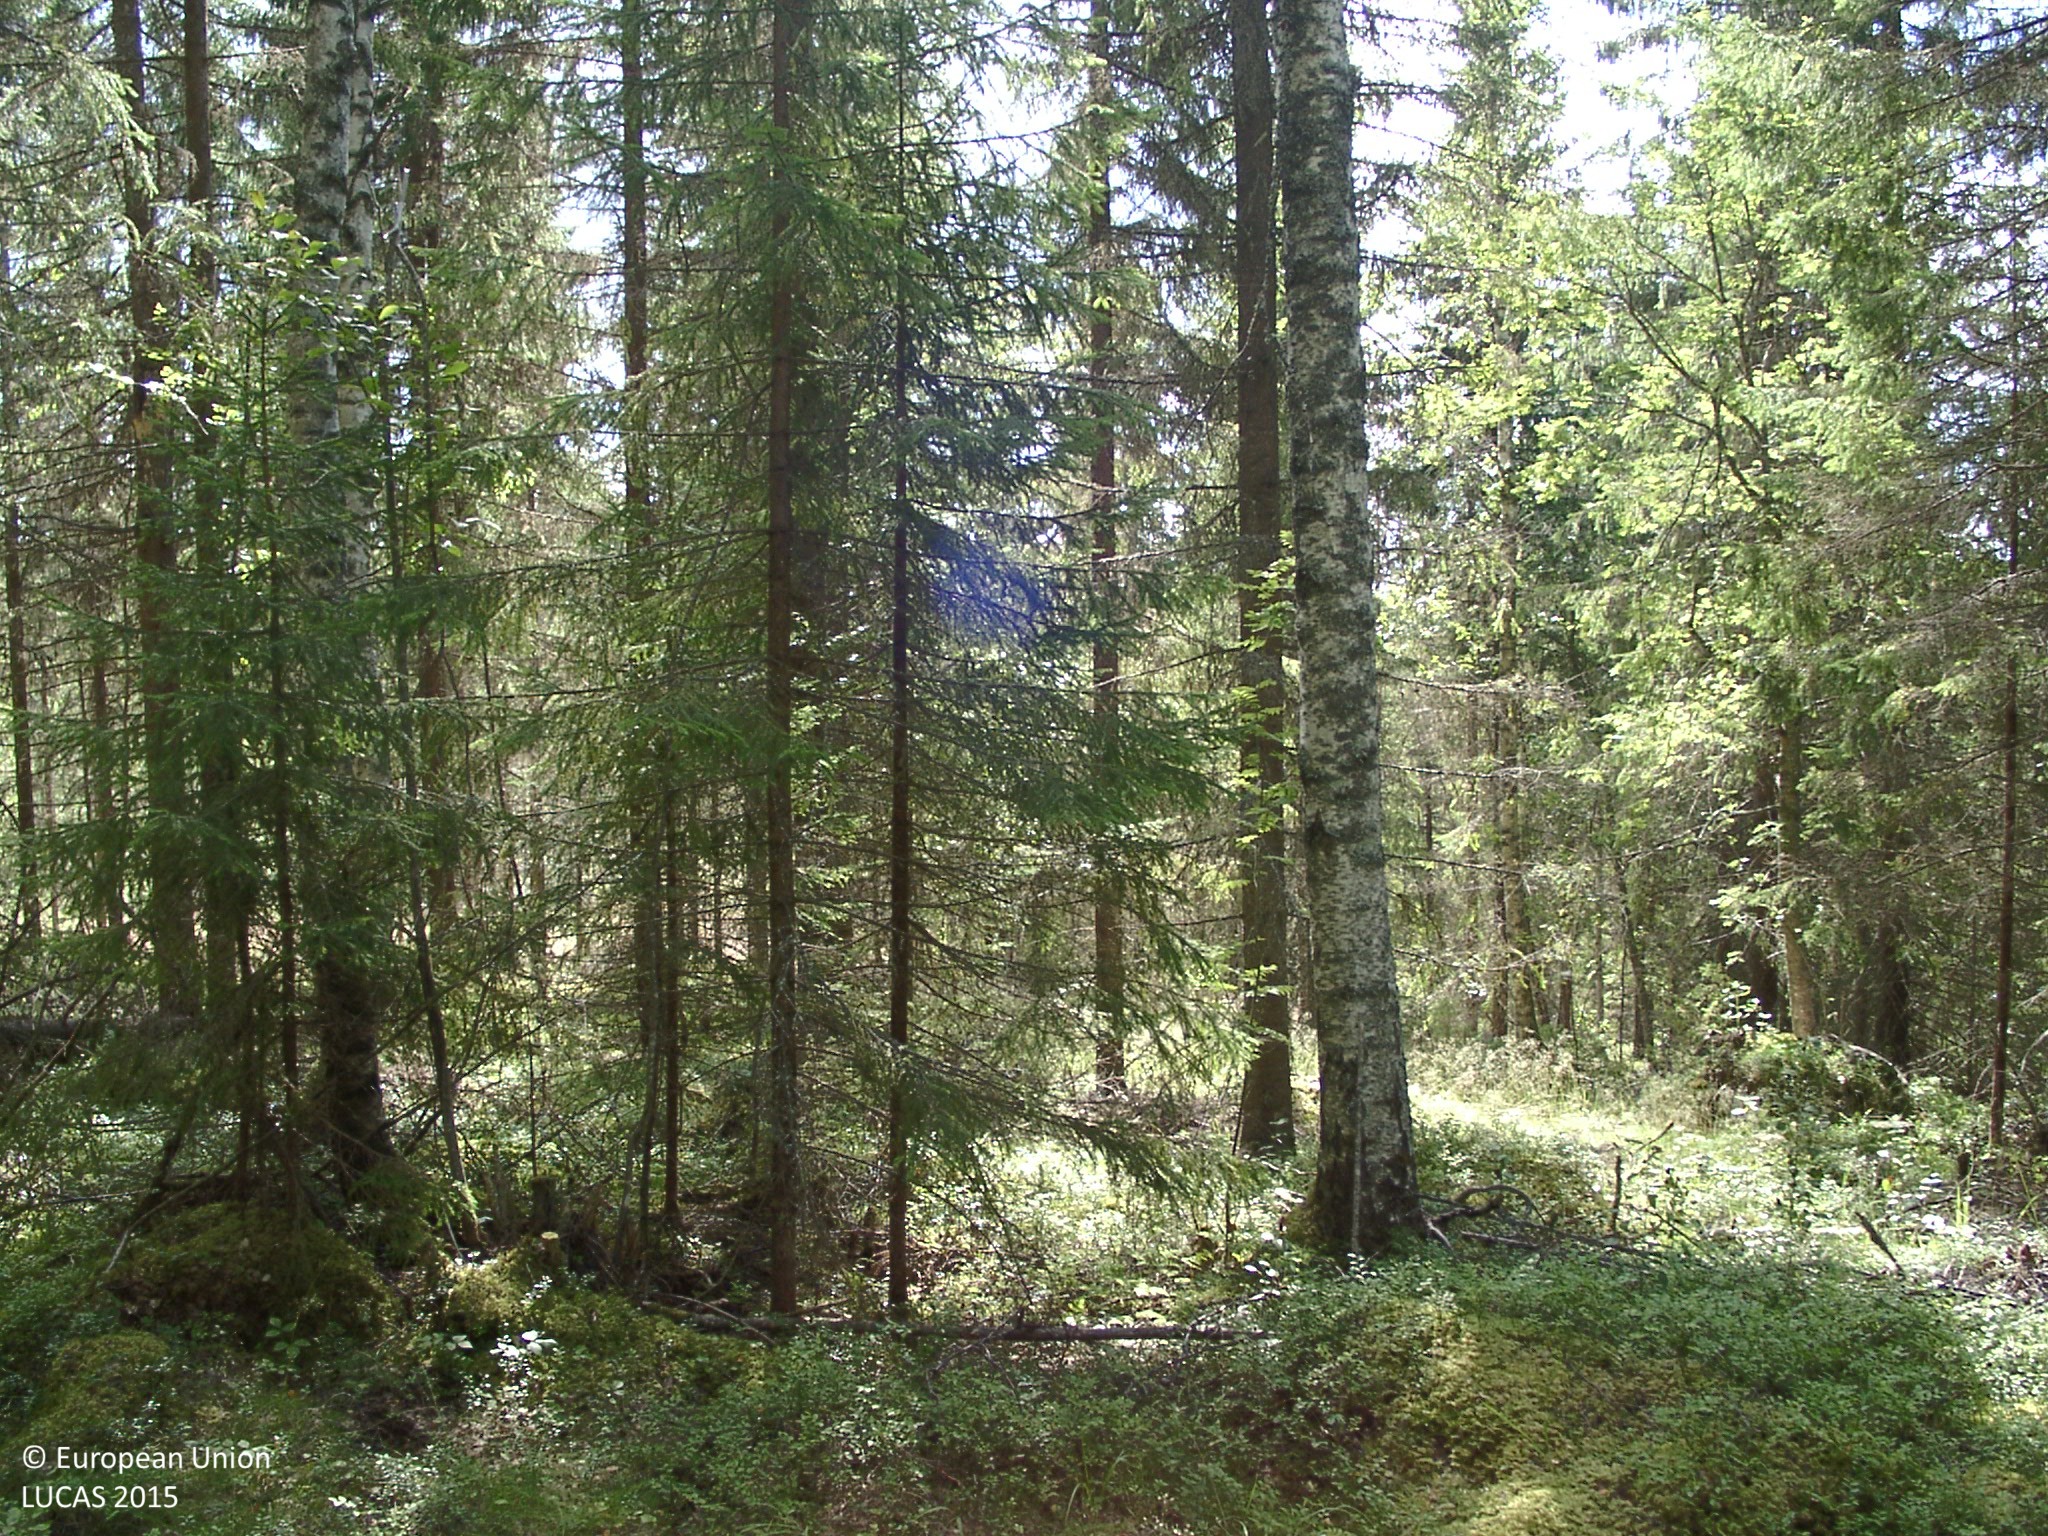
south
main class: Woodland
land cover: Spruce dominated mixed woodland
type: boreal forest
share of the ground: 50 - 75 %
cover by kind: coniferous forest trees 50 %, broadleaved forest trees 20 %, shrubs 15 %, lichens and mosses 10 %, herbaceous plants 5 %
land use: Forestry
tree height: > 5 m
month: August
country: FI
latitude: 62.9367
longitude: 25.0502
